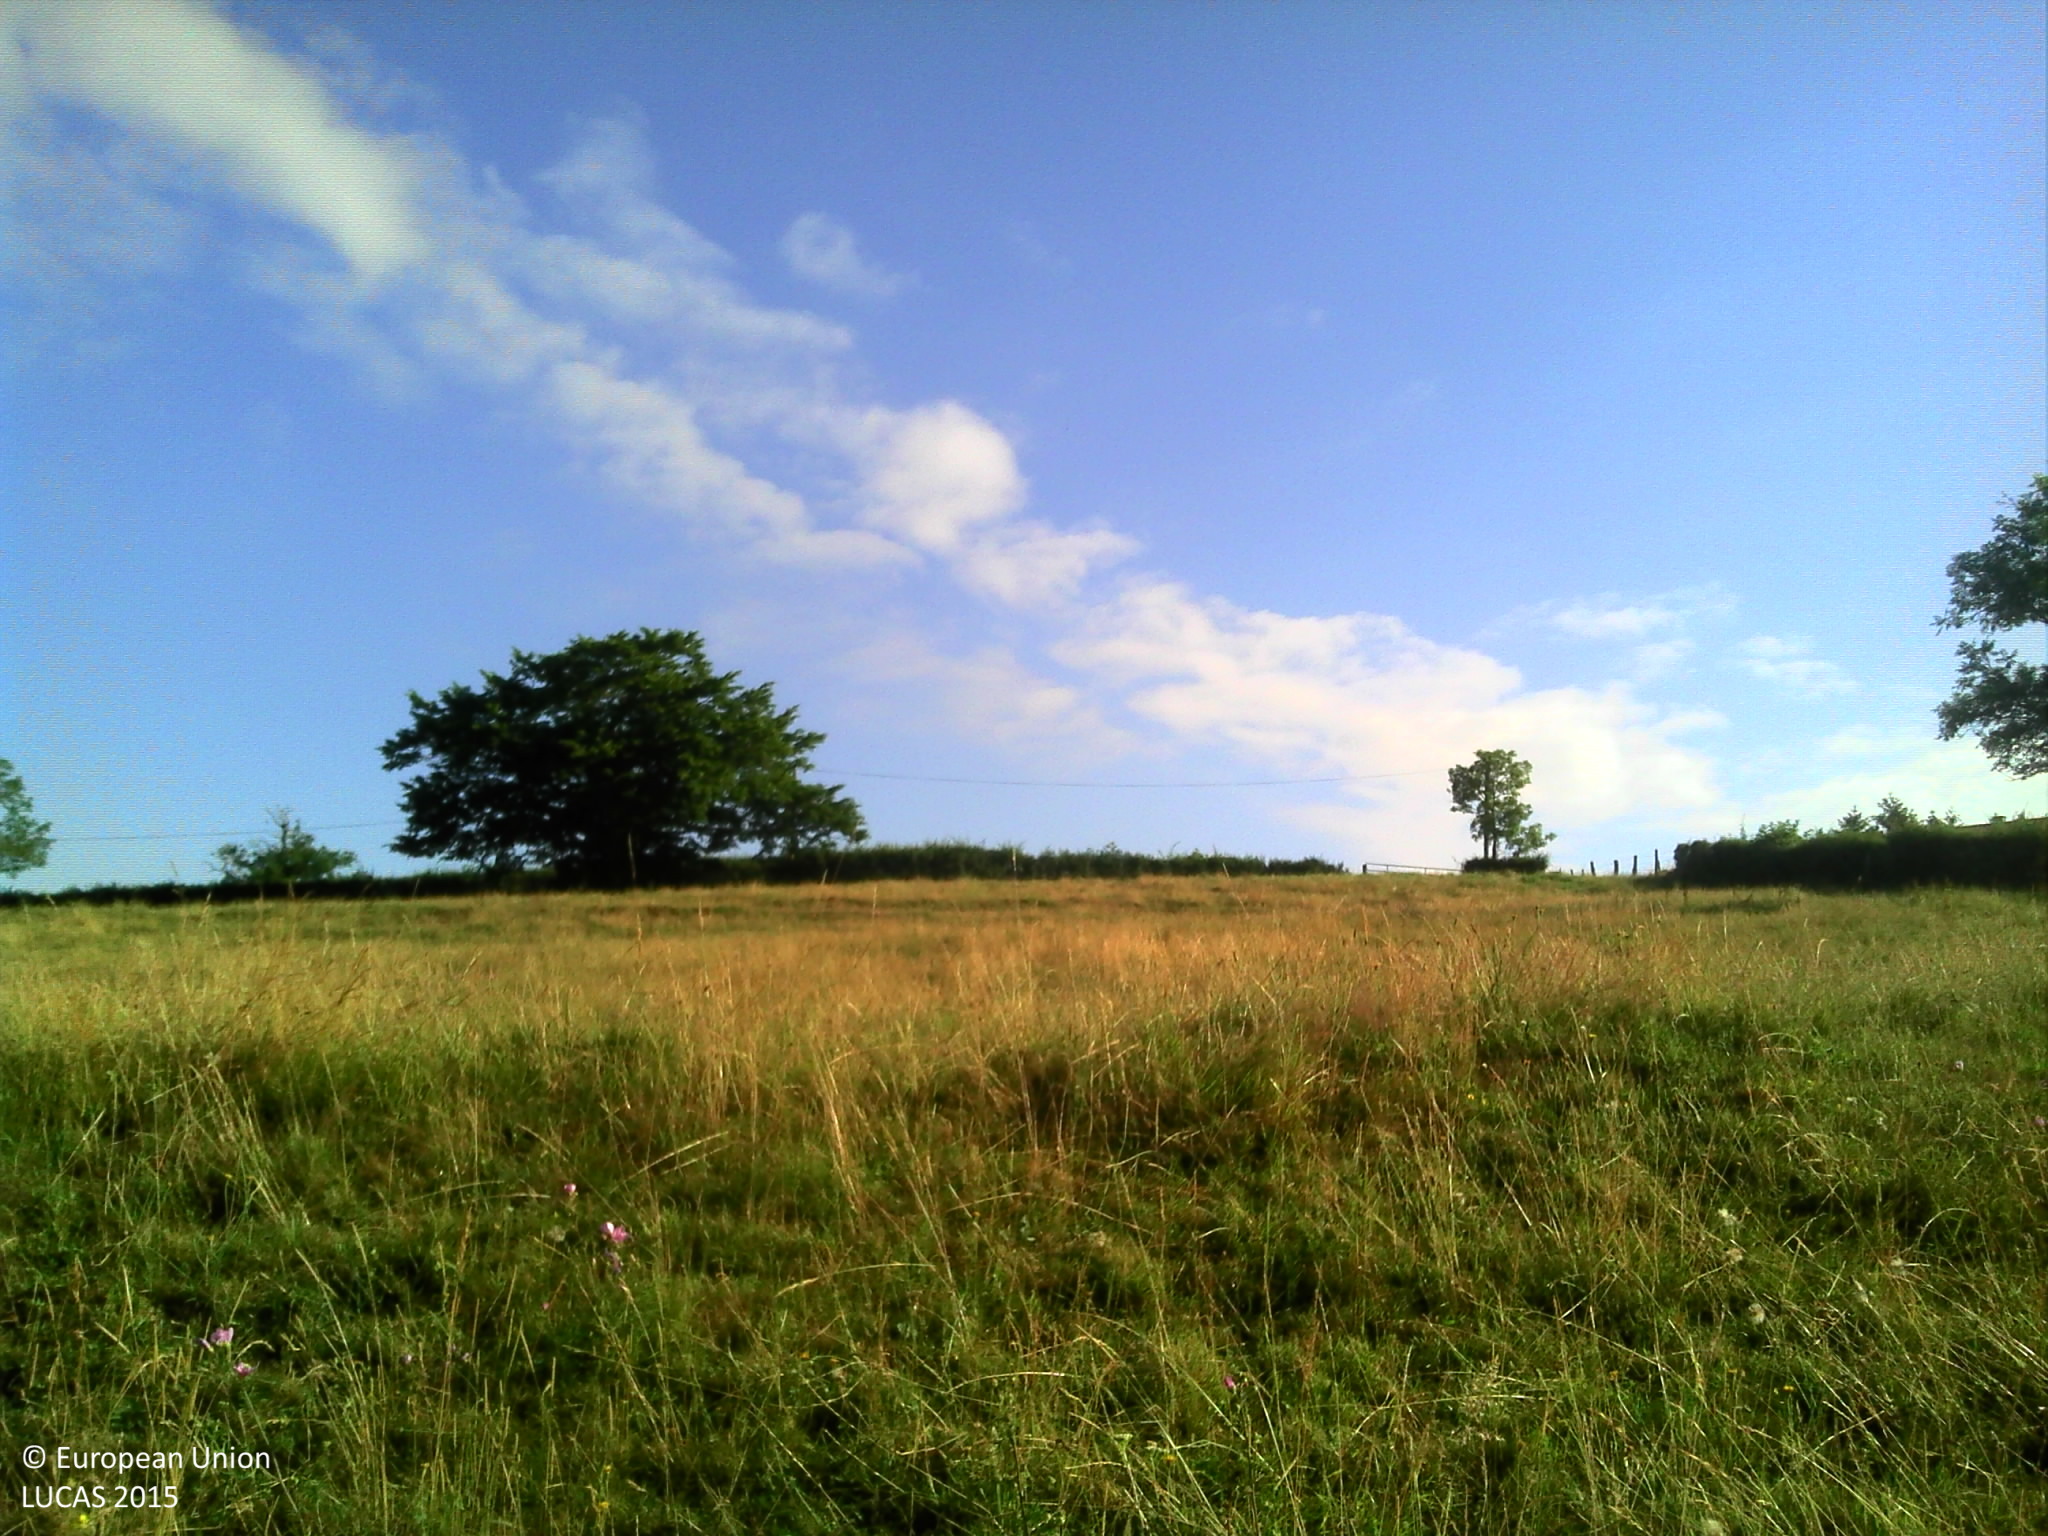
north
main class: Grassland
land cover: Grassland without tree/shrub cover
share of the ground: > 75 %
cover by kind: herbaceous plants 100 %
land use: Agriculture (excluding fallow land and kitchen gardens)
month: June
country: FR
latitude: 46.4967
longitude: 4.4637
